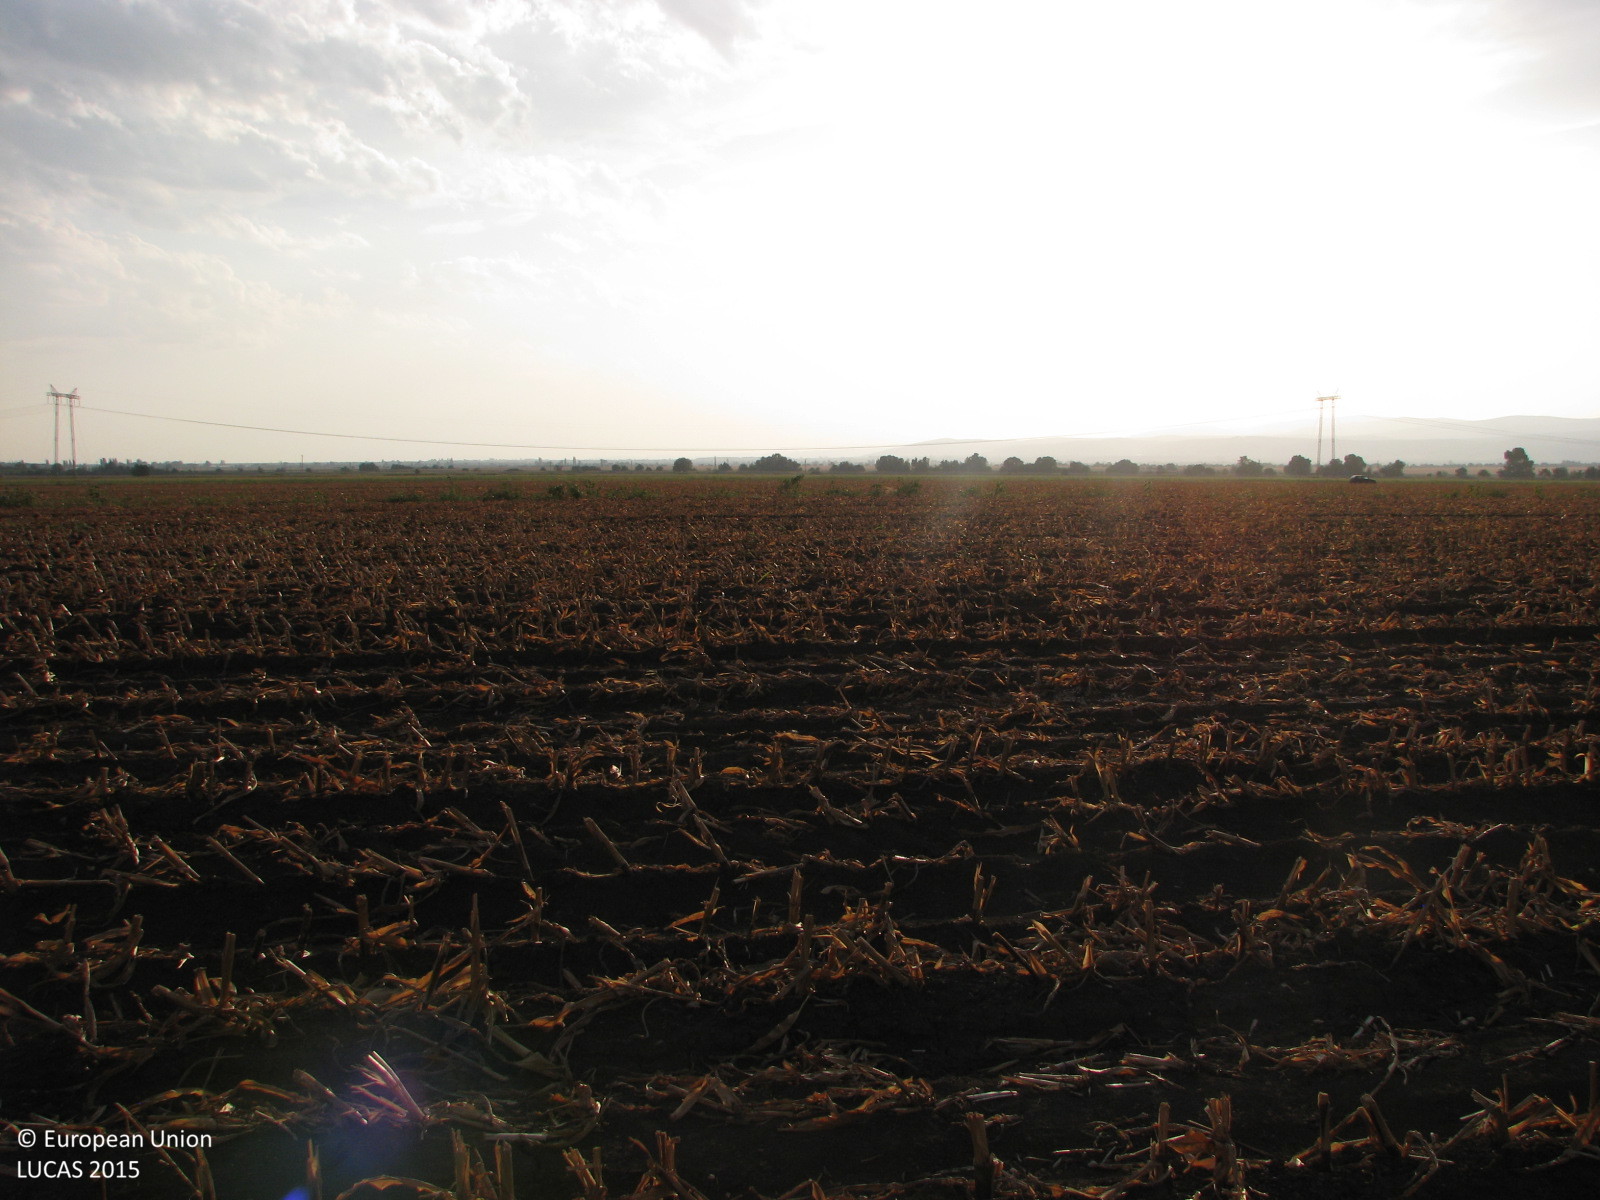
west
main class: Cropland
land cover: Maize
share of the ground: 25 - 50 %
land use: Agriculture (excluding fallow land and kitchen gardens)
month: September
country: BG
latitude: 42.5234
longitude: 26.0409
